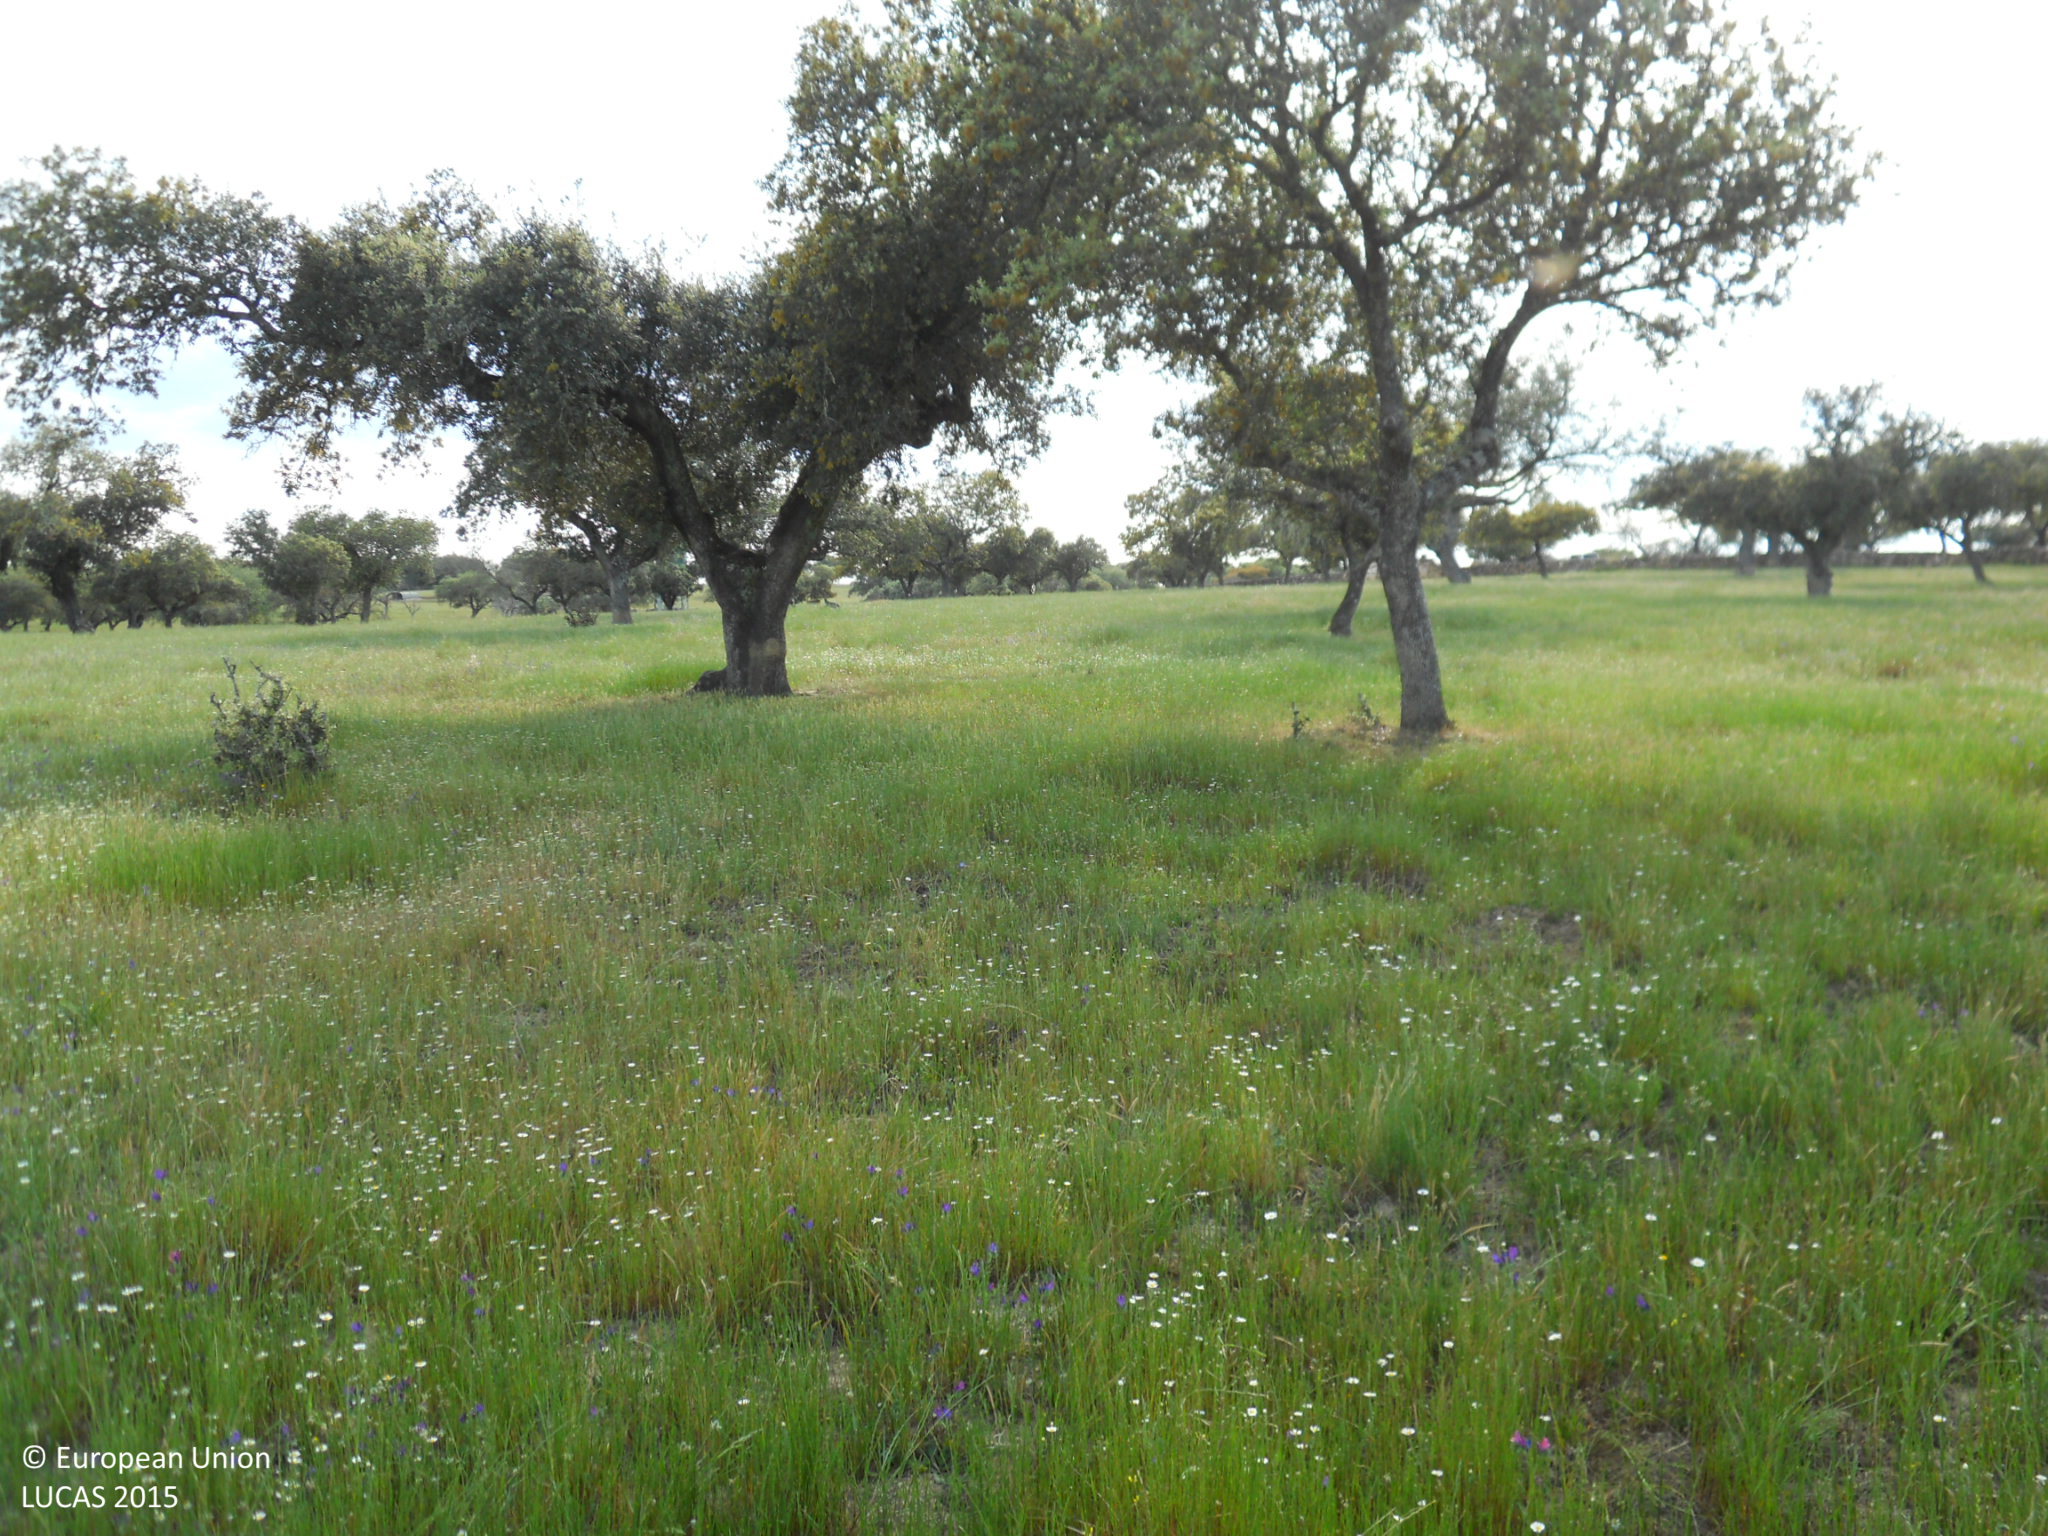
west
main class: Woodland
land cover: Broadleaved woodland
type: broadleaved evergreen forest
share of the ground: 10 - 25 %
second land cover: Grassland without tree/shrub cover
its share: > 75 %
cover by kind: herbaceous plants 65 %, broadleaved forest trees 35 %
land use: Forestry
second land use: Agriculture (excluding fallow land and kitchen gardens)
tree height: > 5 m
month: April
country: ES
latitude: 39.2857
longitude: -6.8030
